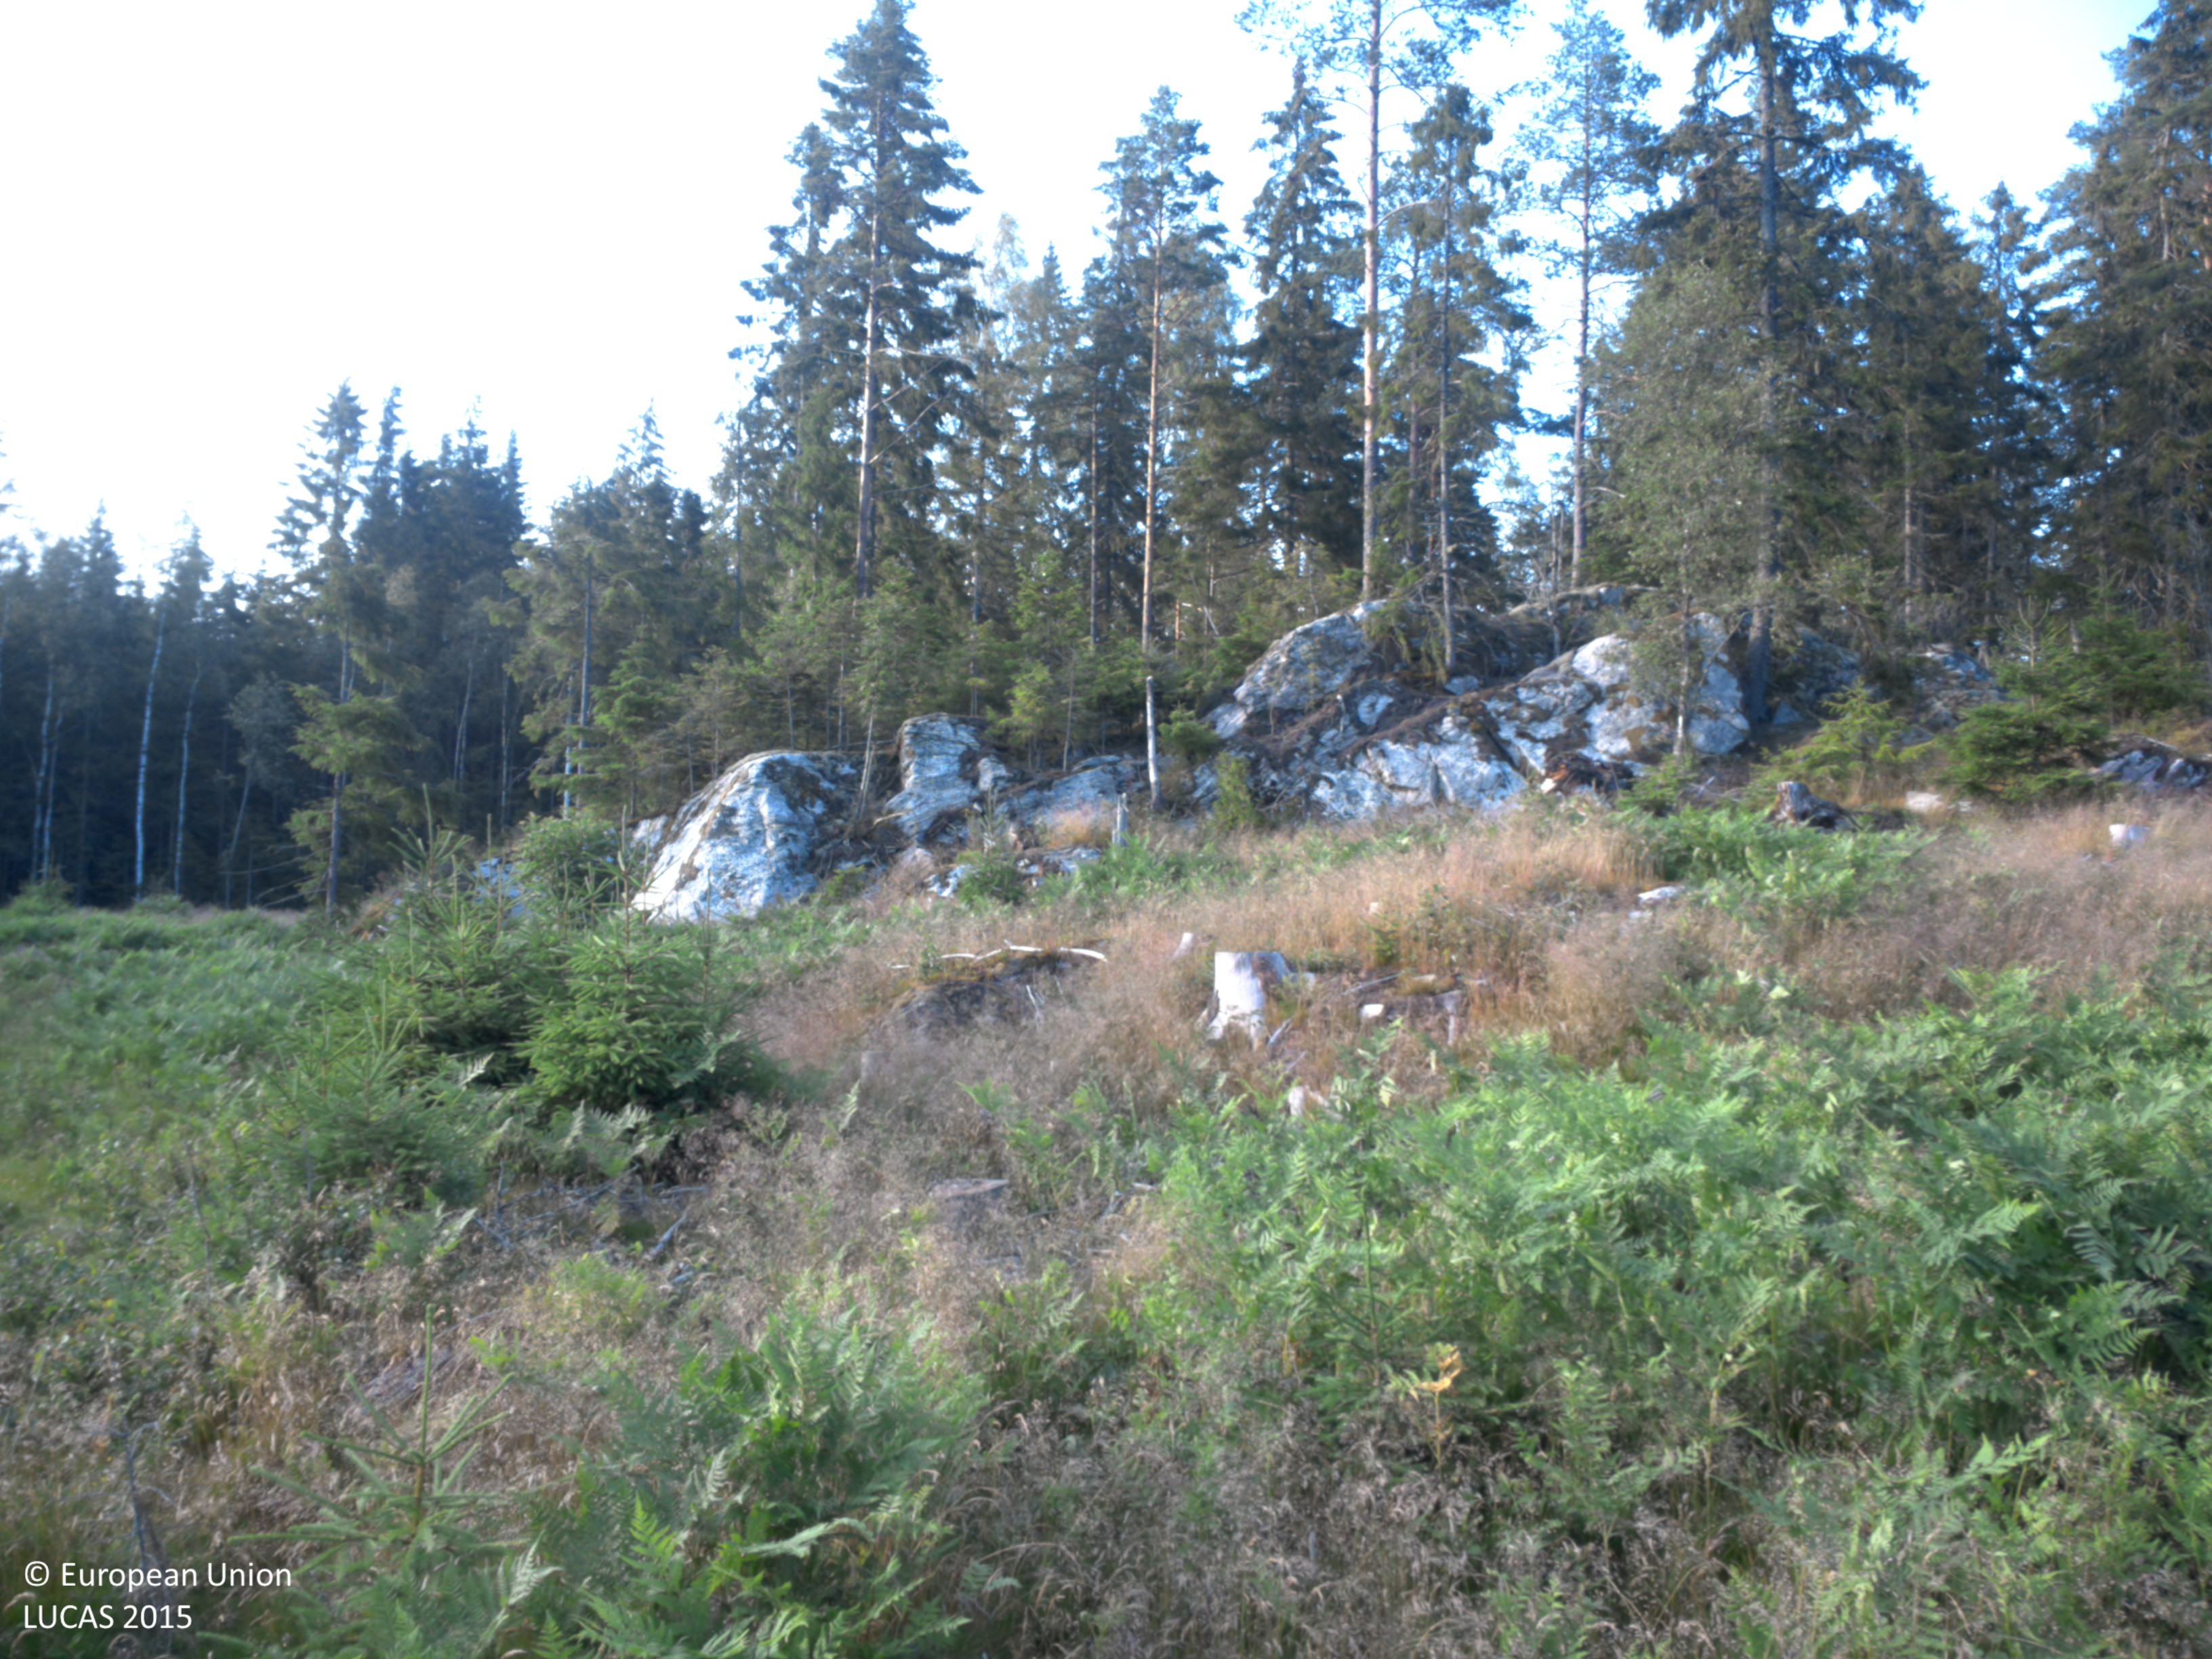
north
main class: Grassland
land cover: Grassland with sparse tree/shrub cover
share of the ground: 25 - 50 %
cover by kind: herbaceous plants 95 %, coniferous forest trees 5 %
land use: Forestry
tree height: < 5 m
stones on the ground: < 10 %
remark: Clear cut
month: July
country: SE
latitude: 58.8360
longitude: 11.8841
